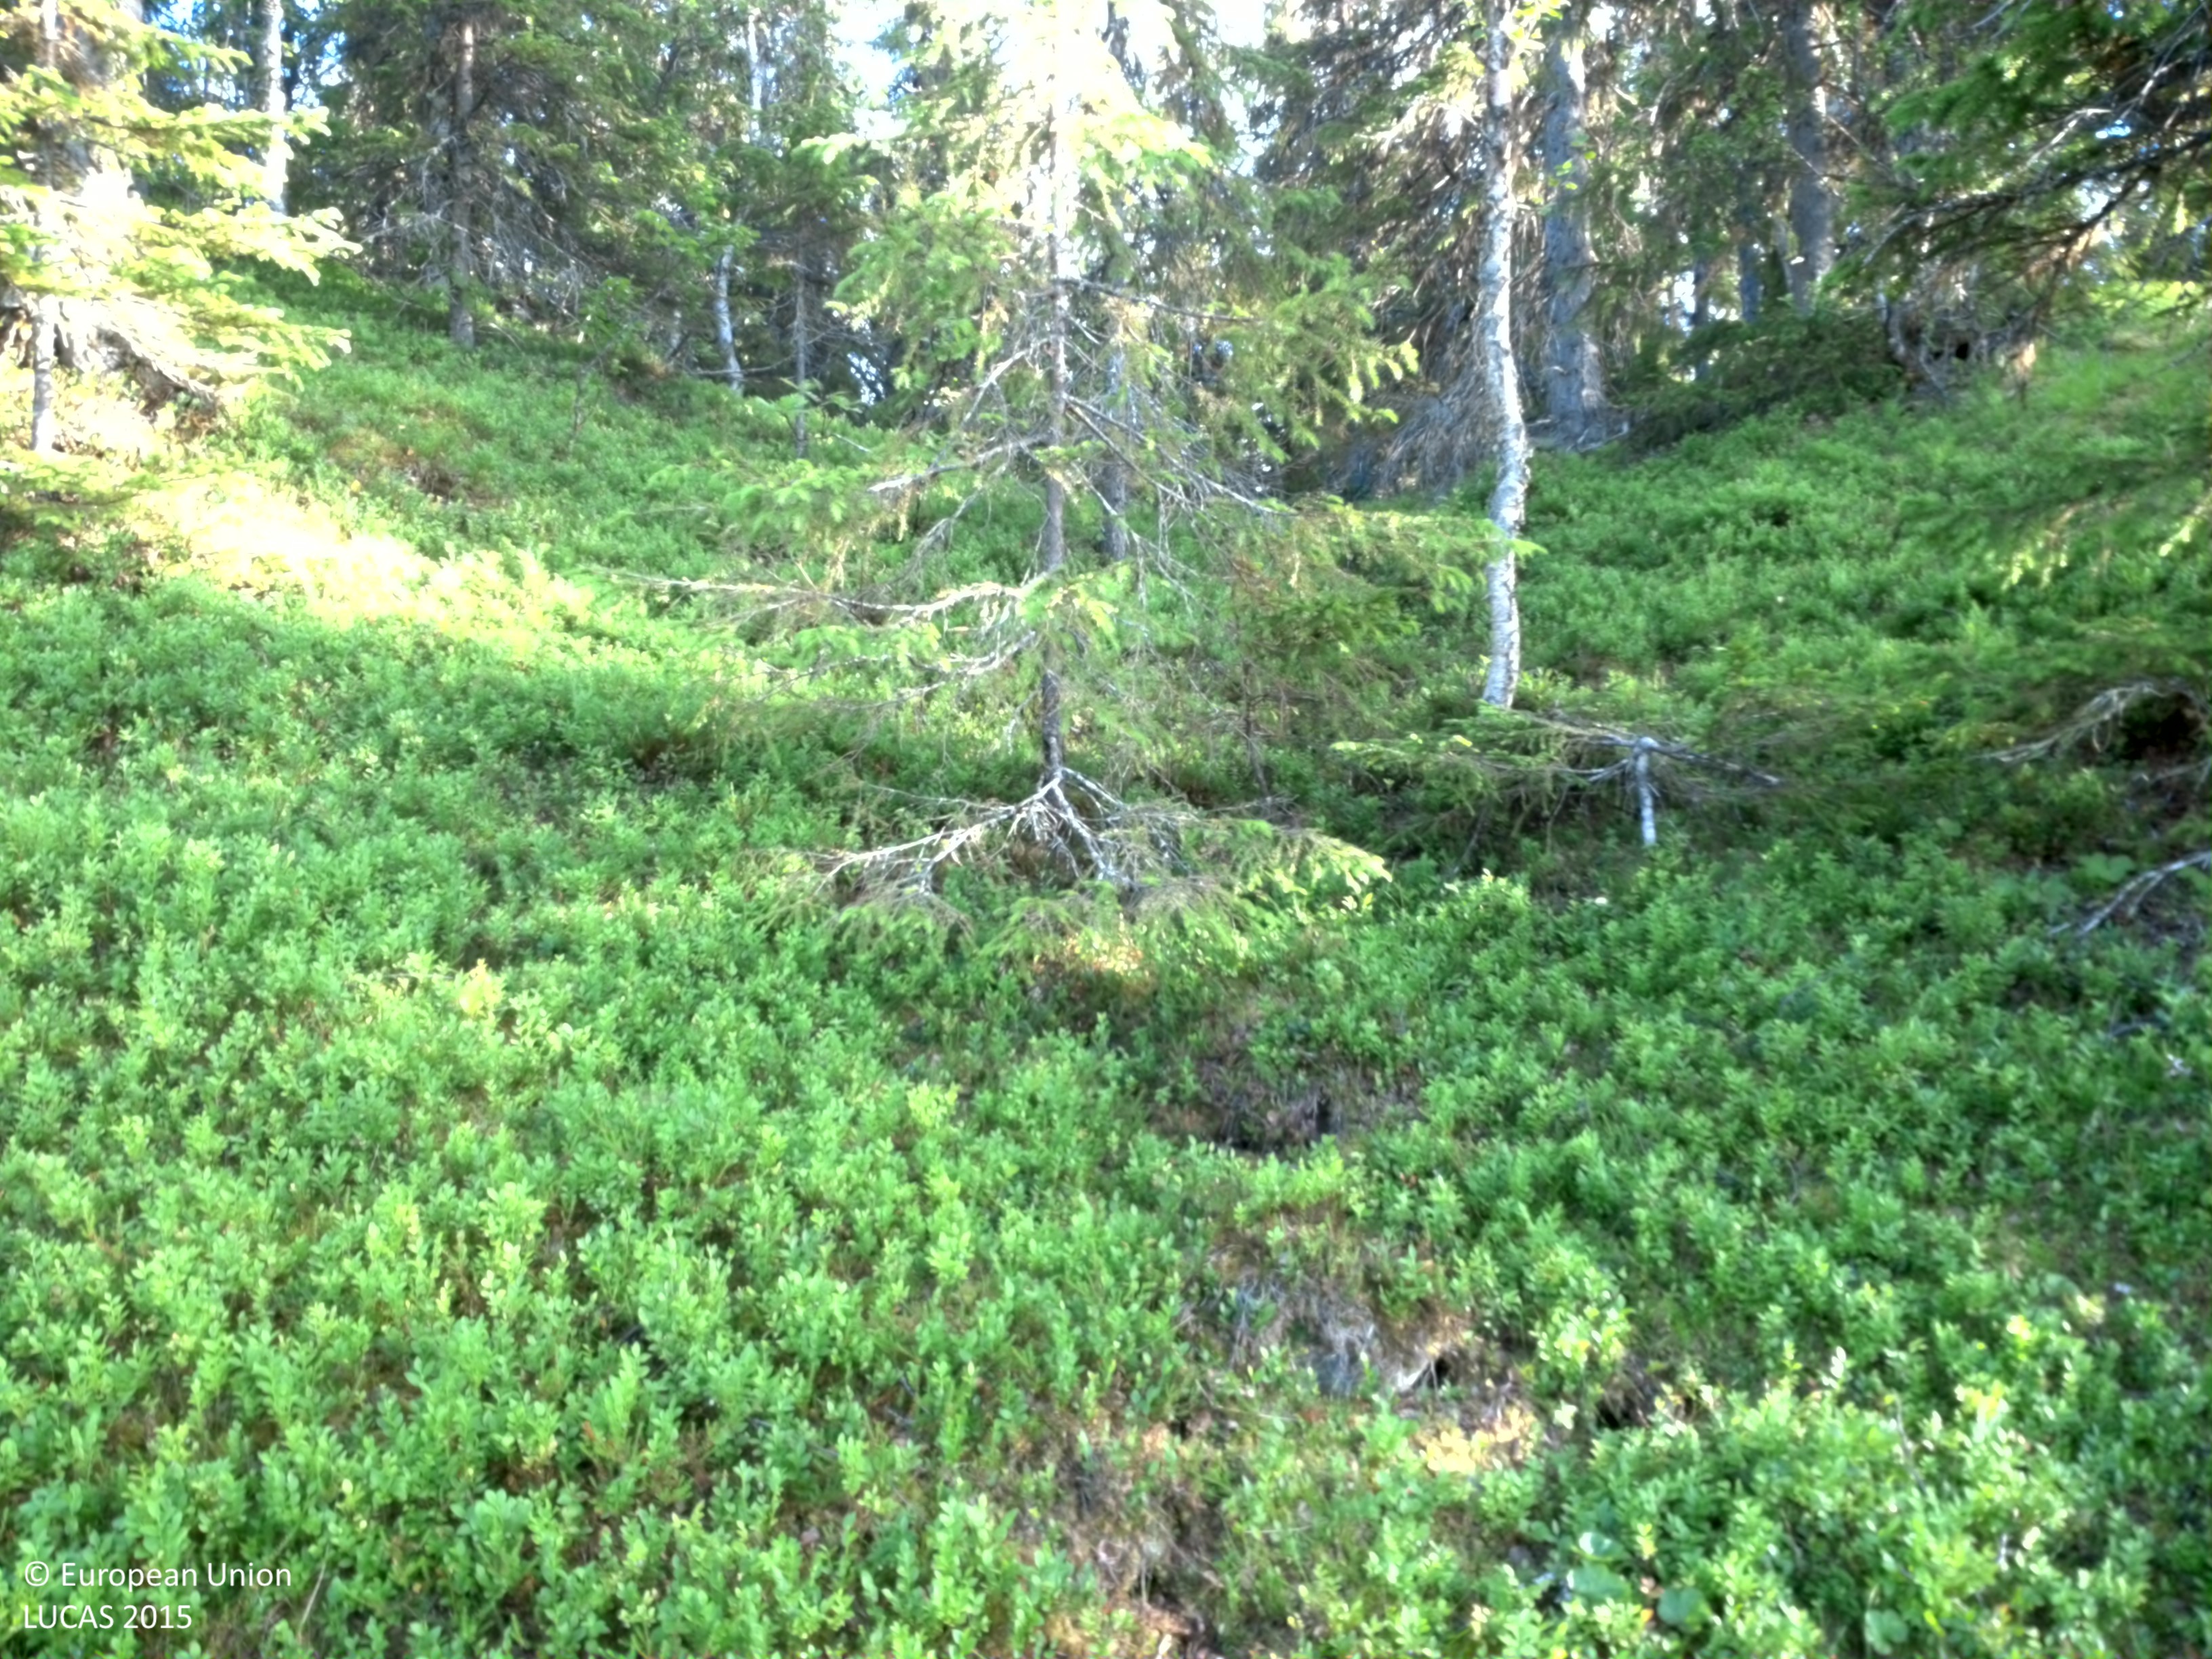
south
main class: Shrubland
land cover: Shrubland with sparse tree cover
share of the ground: 25 - 50 %
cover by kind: herbaceous plants 45 %, lichens and mosses 30 %, shrubs 20 %, broadleaved forest trees 5 %
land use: Semi-natural and natural areas not in use
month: August
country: SE
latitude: 64.8995
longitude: 15.5244
